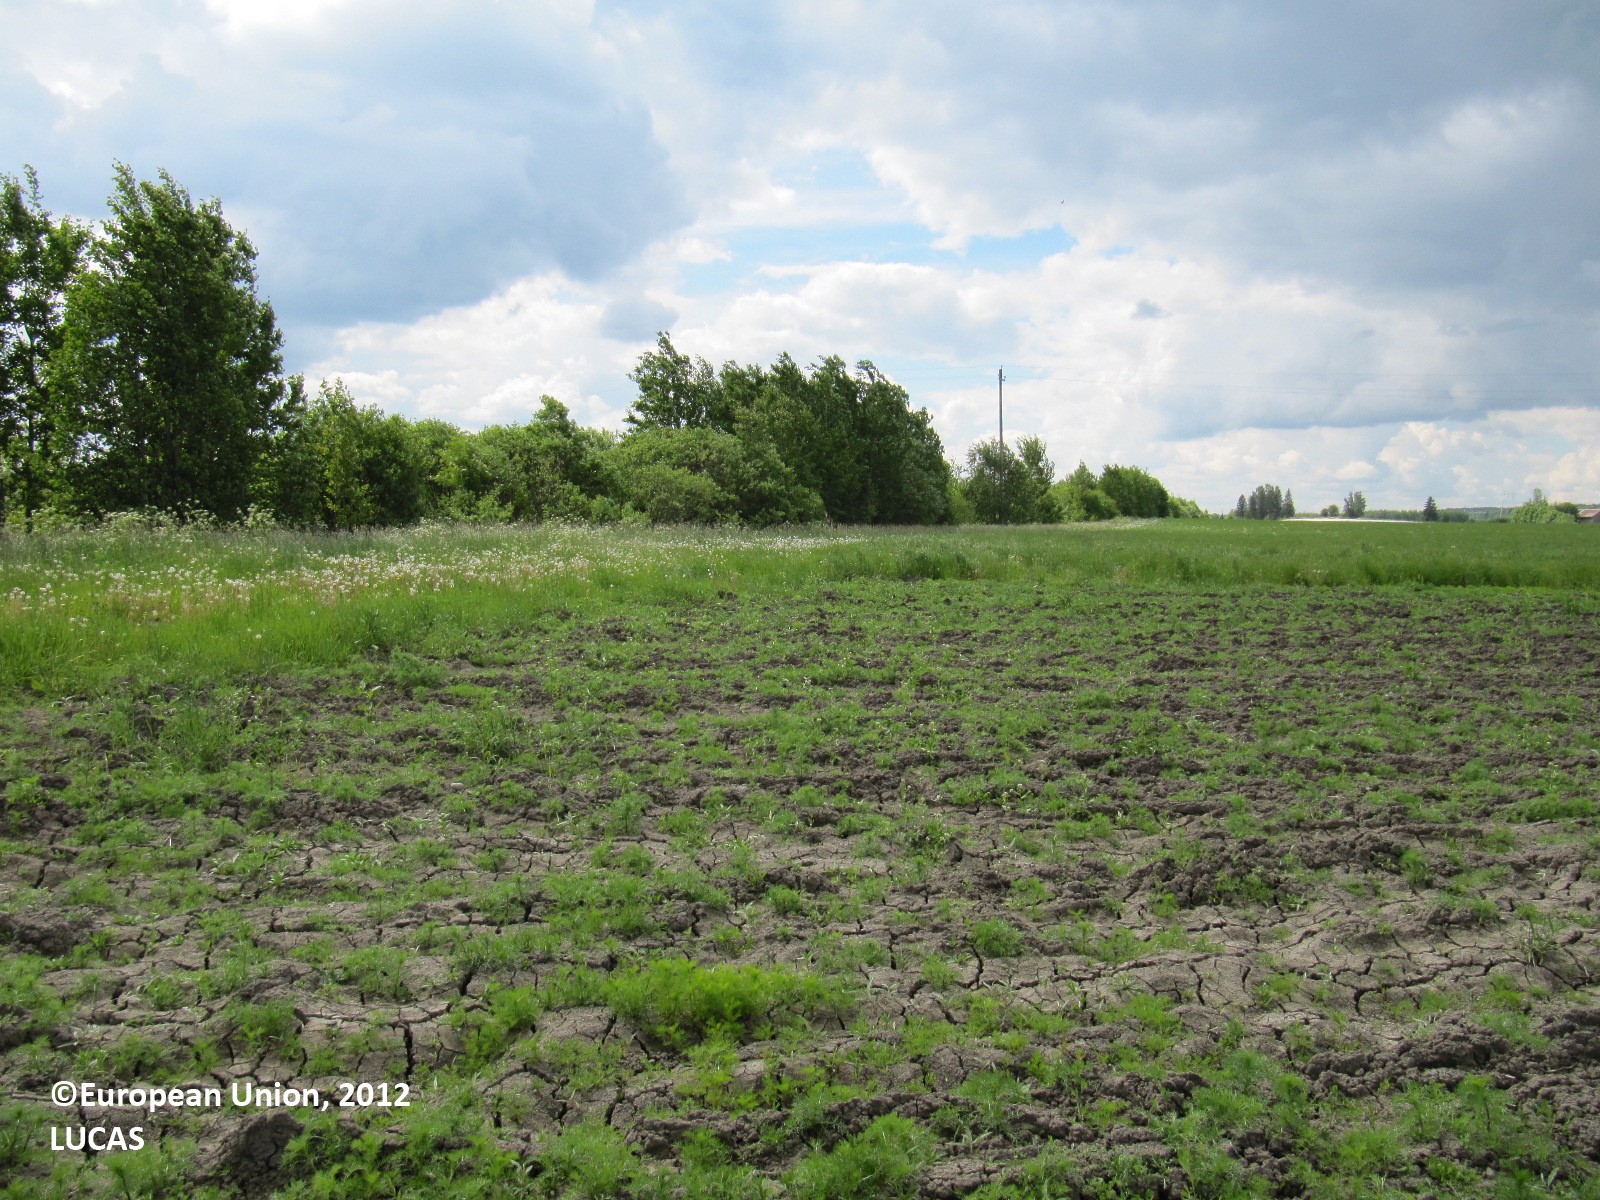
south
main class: Cropland
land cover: Other non-permanent industrial crops
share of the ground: 25 - 50 %
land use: Fallow land
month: June
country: FI
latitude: 60.3567
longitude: 24.3695
